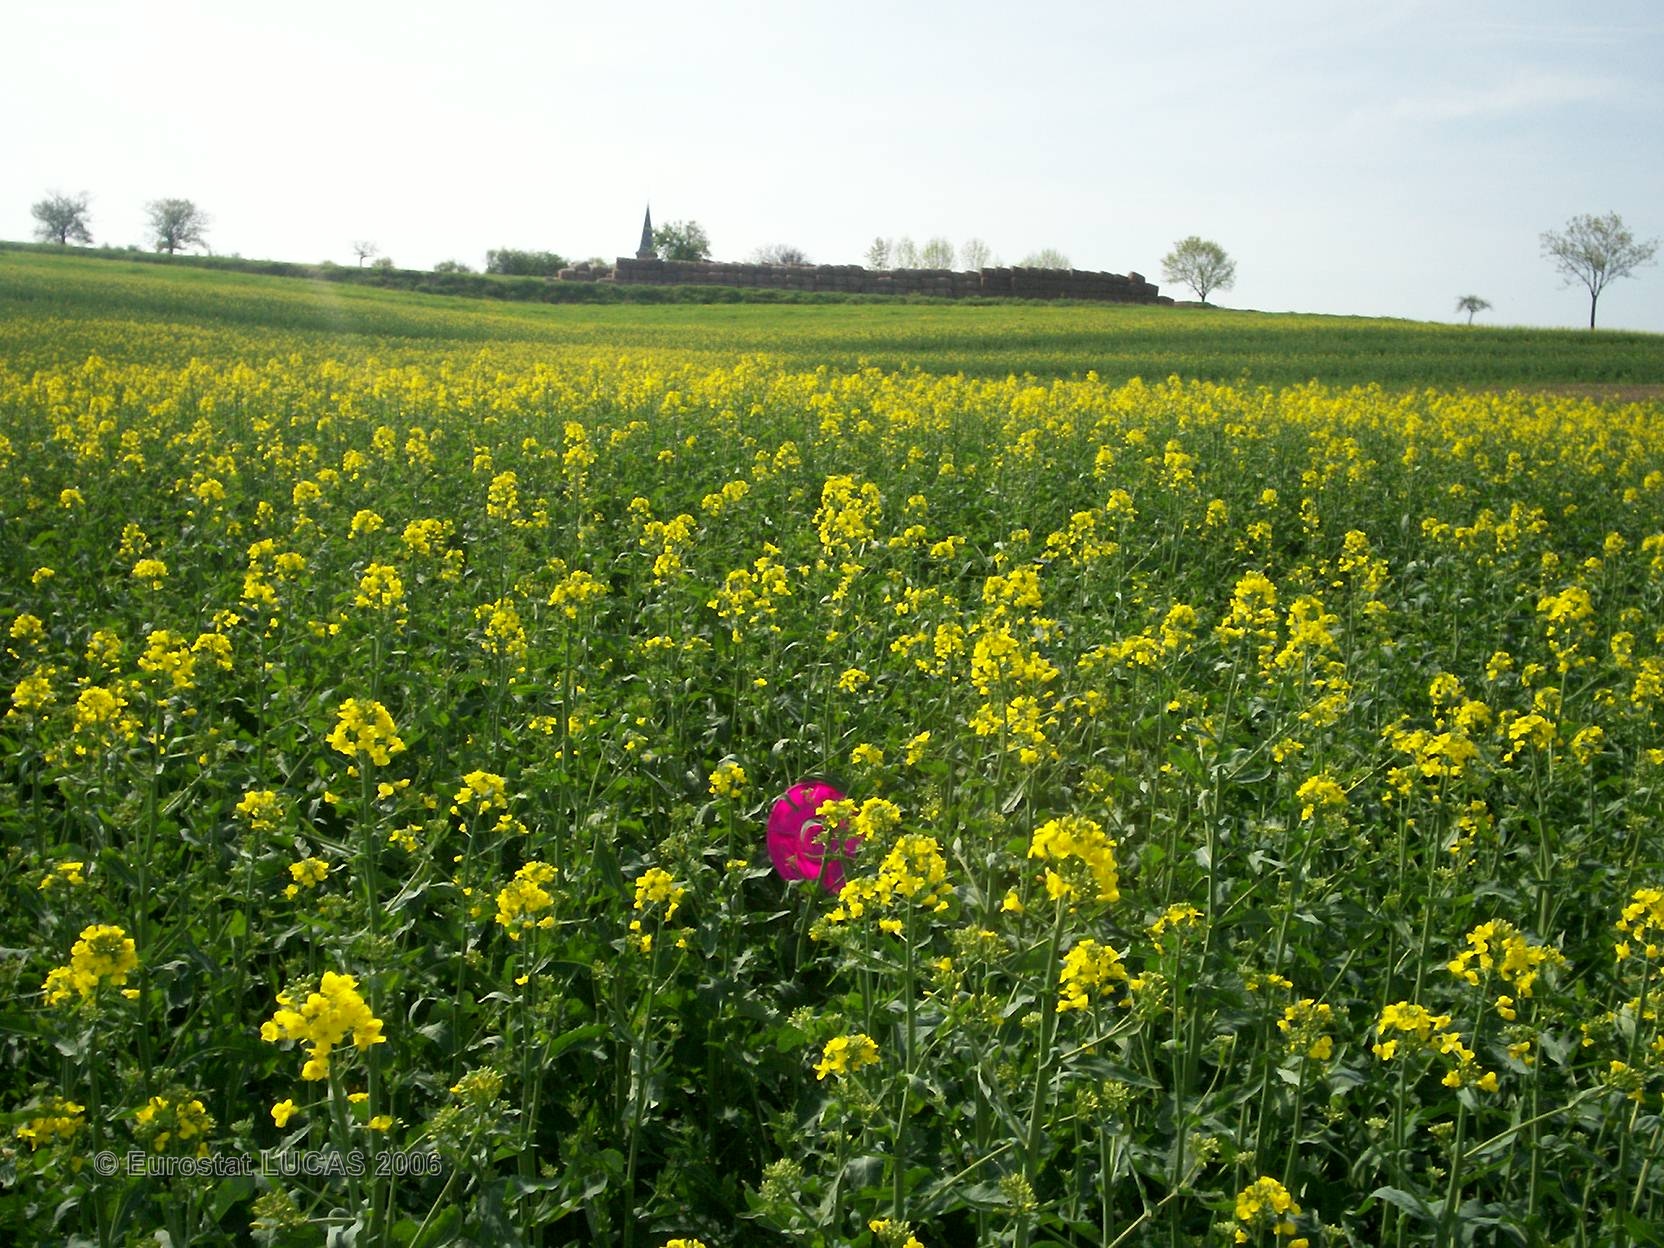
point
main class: Cropland
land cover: Rape and turnip rape
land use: Agriculture (excluding fallow land and kitchen gardens)
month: May
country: FR
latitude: 48.9550
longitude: 6.9277
